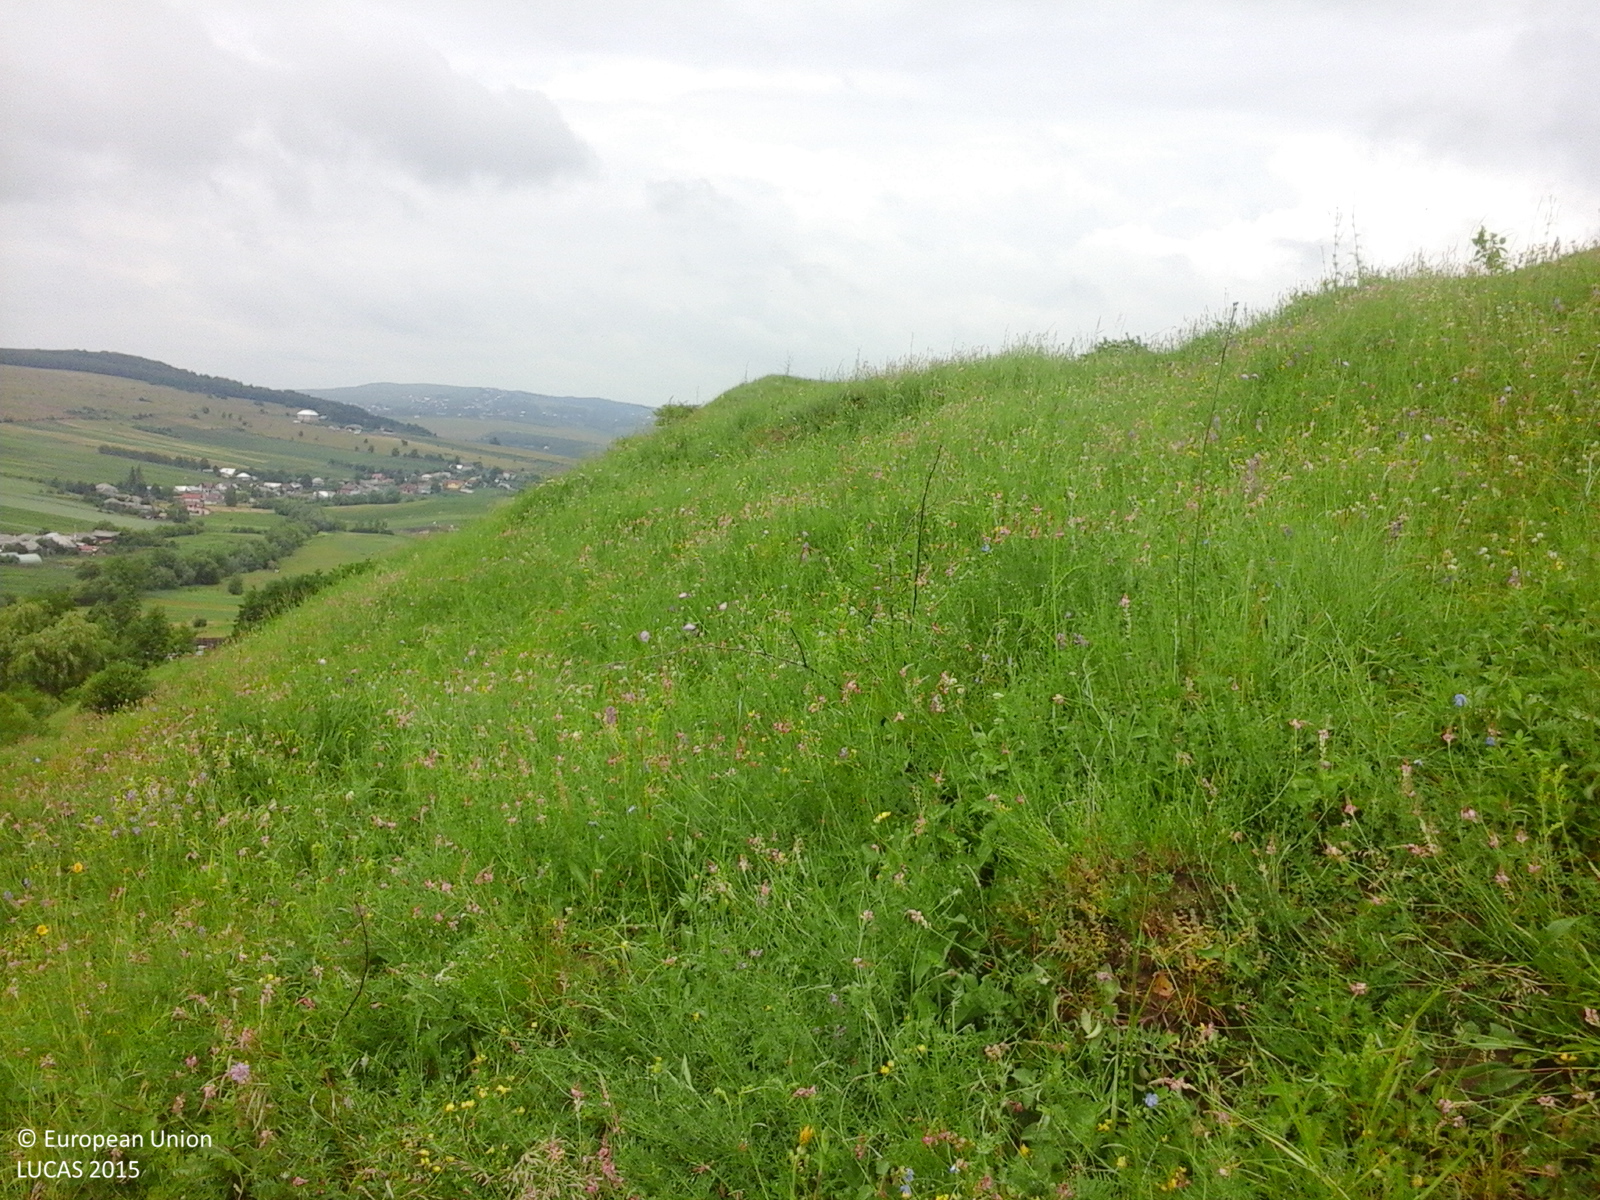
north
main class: Grassland
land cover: Grassland without tree/shrub cover
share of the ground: > 75 %
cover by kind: herbaceous plants 100 %
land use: Agriculture (excluding fallow land and kitchen gardens)
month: June
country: RO
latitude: 47.4281
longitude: 26.3782
